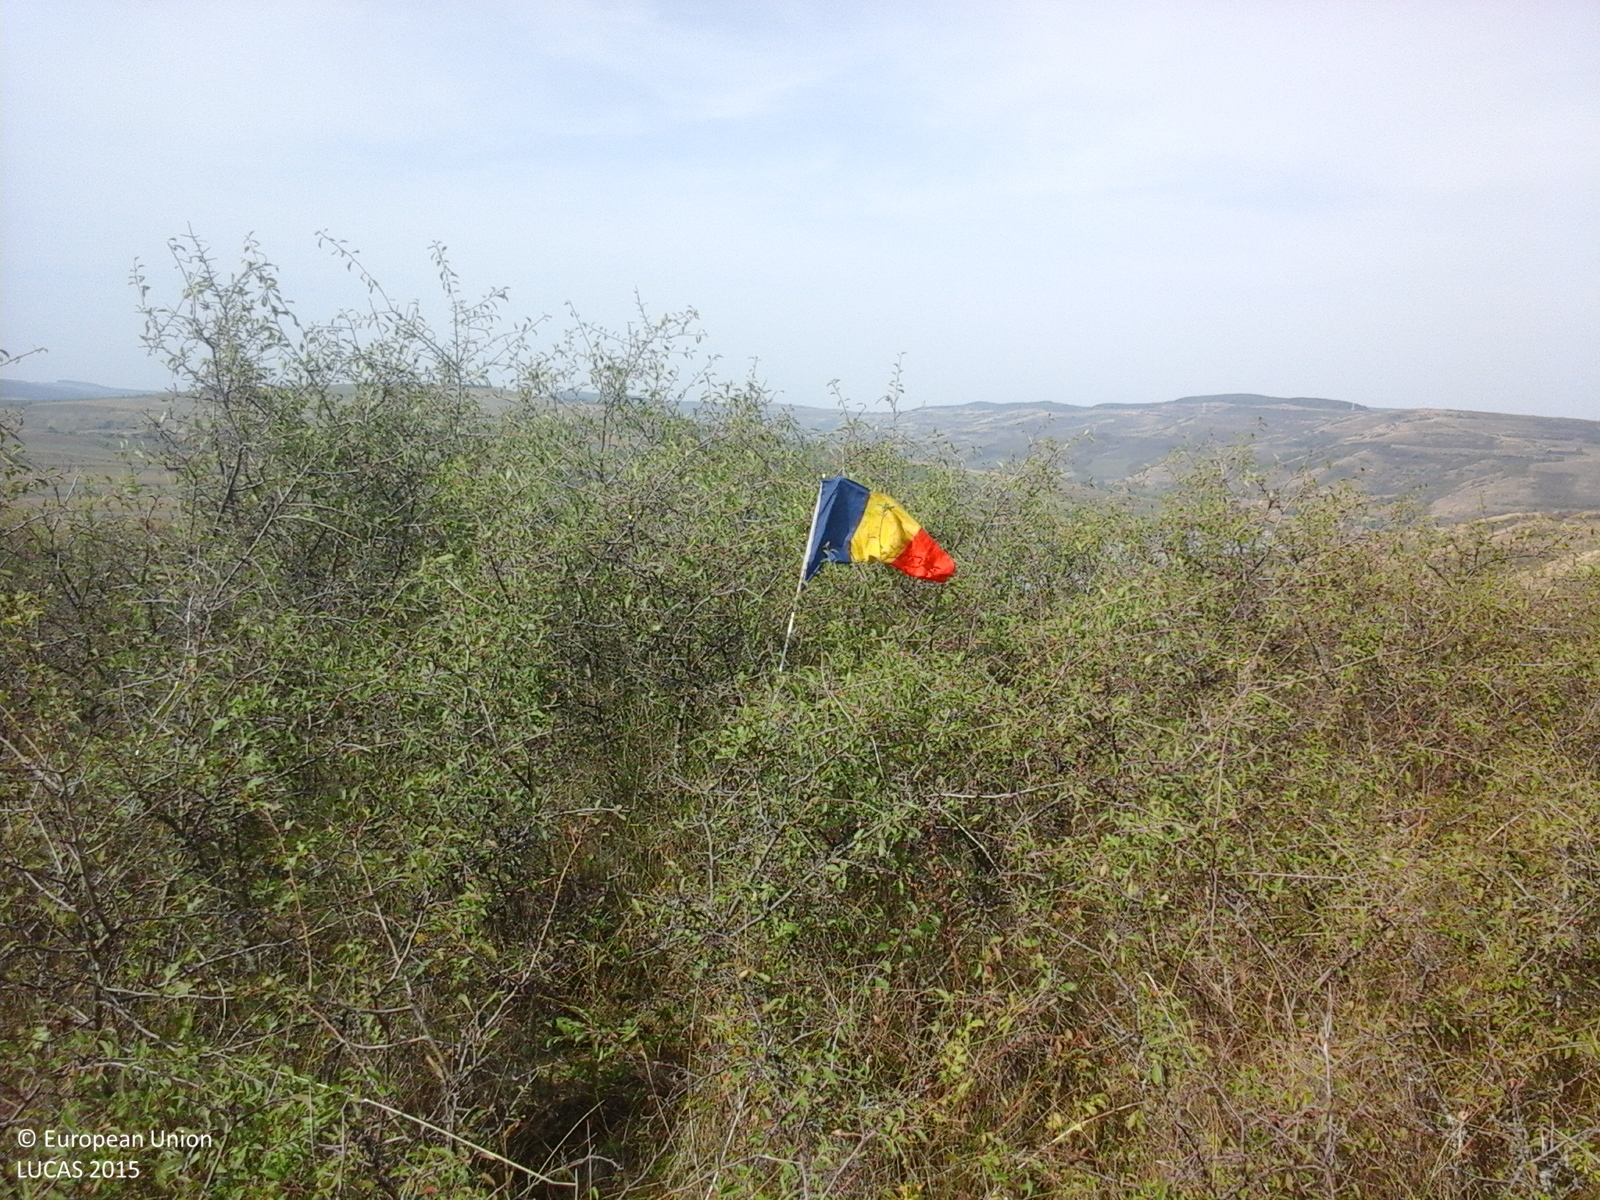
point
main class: Shrubland
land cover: Shrubland with sparse tree cover
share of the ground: > 75 %
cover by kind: herbaceous plants 55 %, shrubs 40 %, broadleaved forest trees 5 %
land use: Fallow land
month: September
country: RO
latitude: 46.8933
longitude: 24.0856
